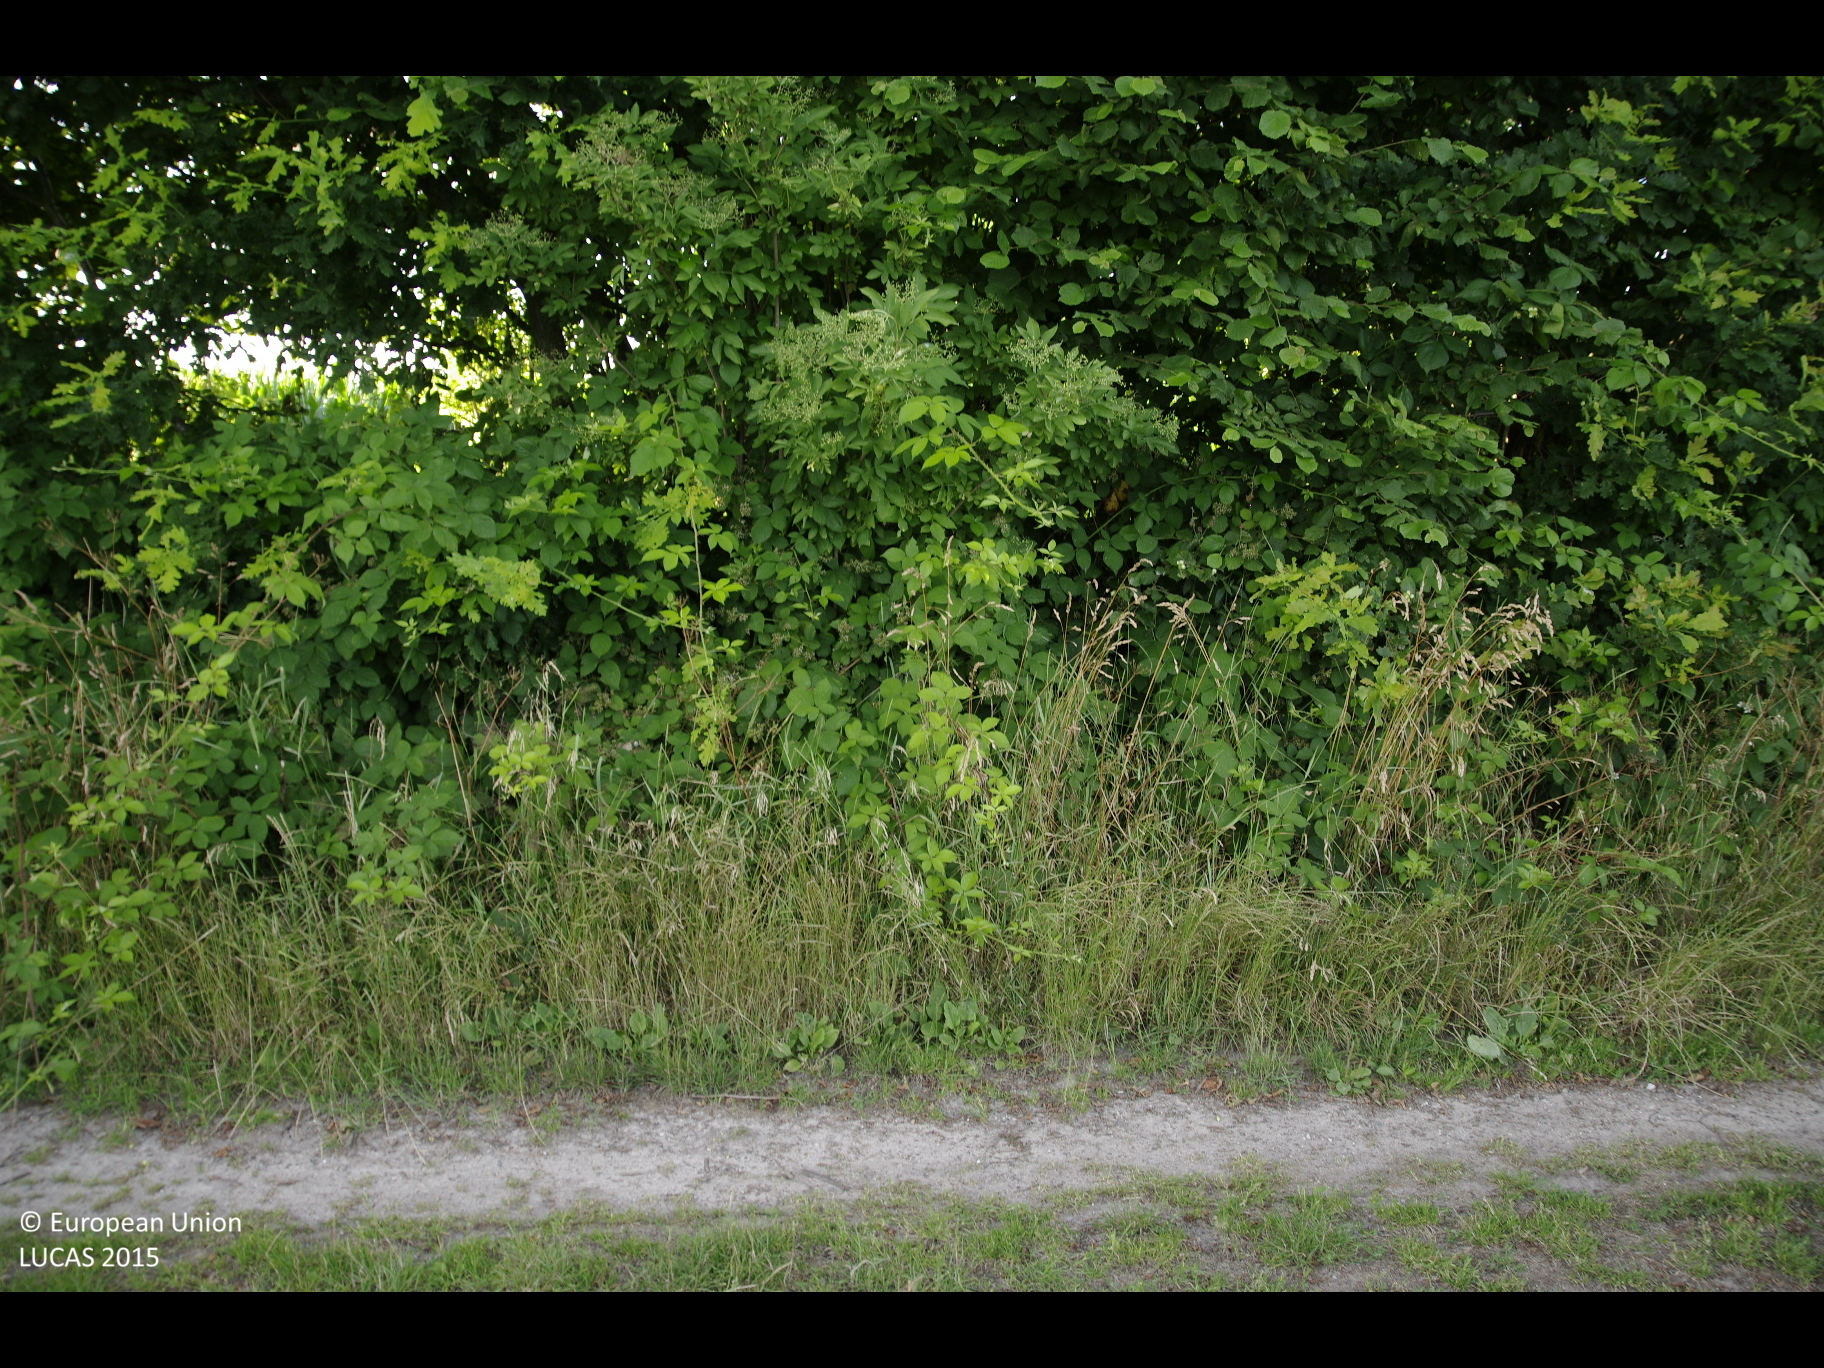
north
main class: Cropland
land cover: Rape and turnip rape
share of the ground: > 75 %
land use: Agriculture (excluding fallow land and kitchen gardens)
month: July
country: DE
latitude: 53.9769
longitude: 9.8324
